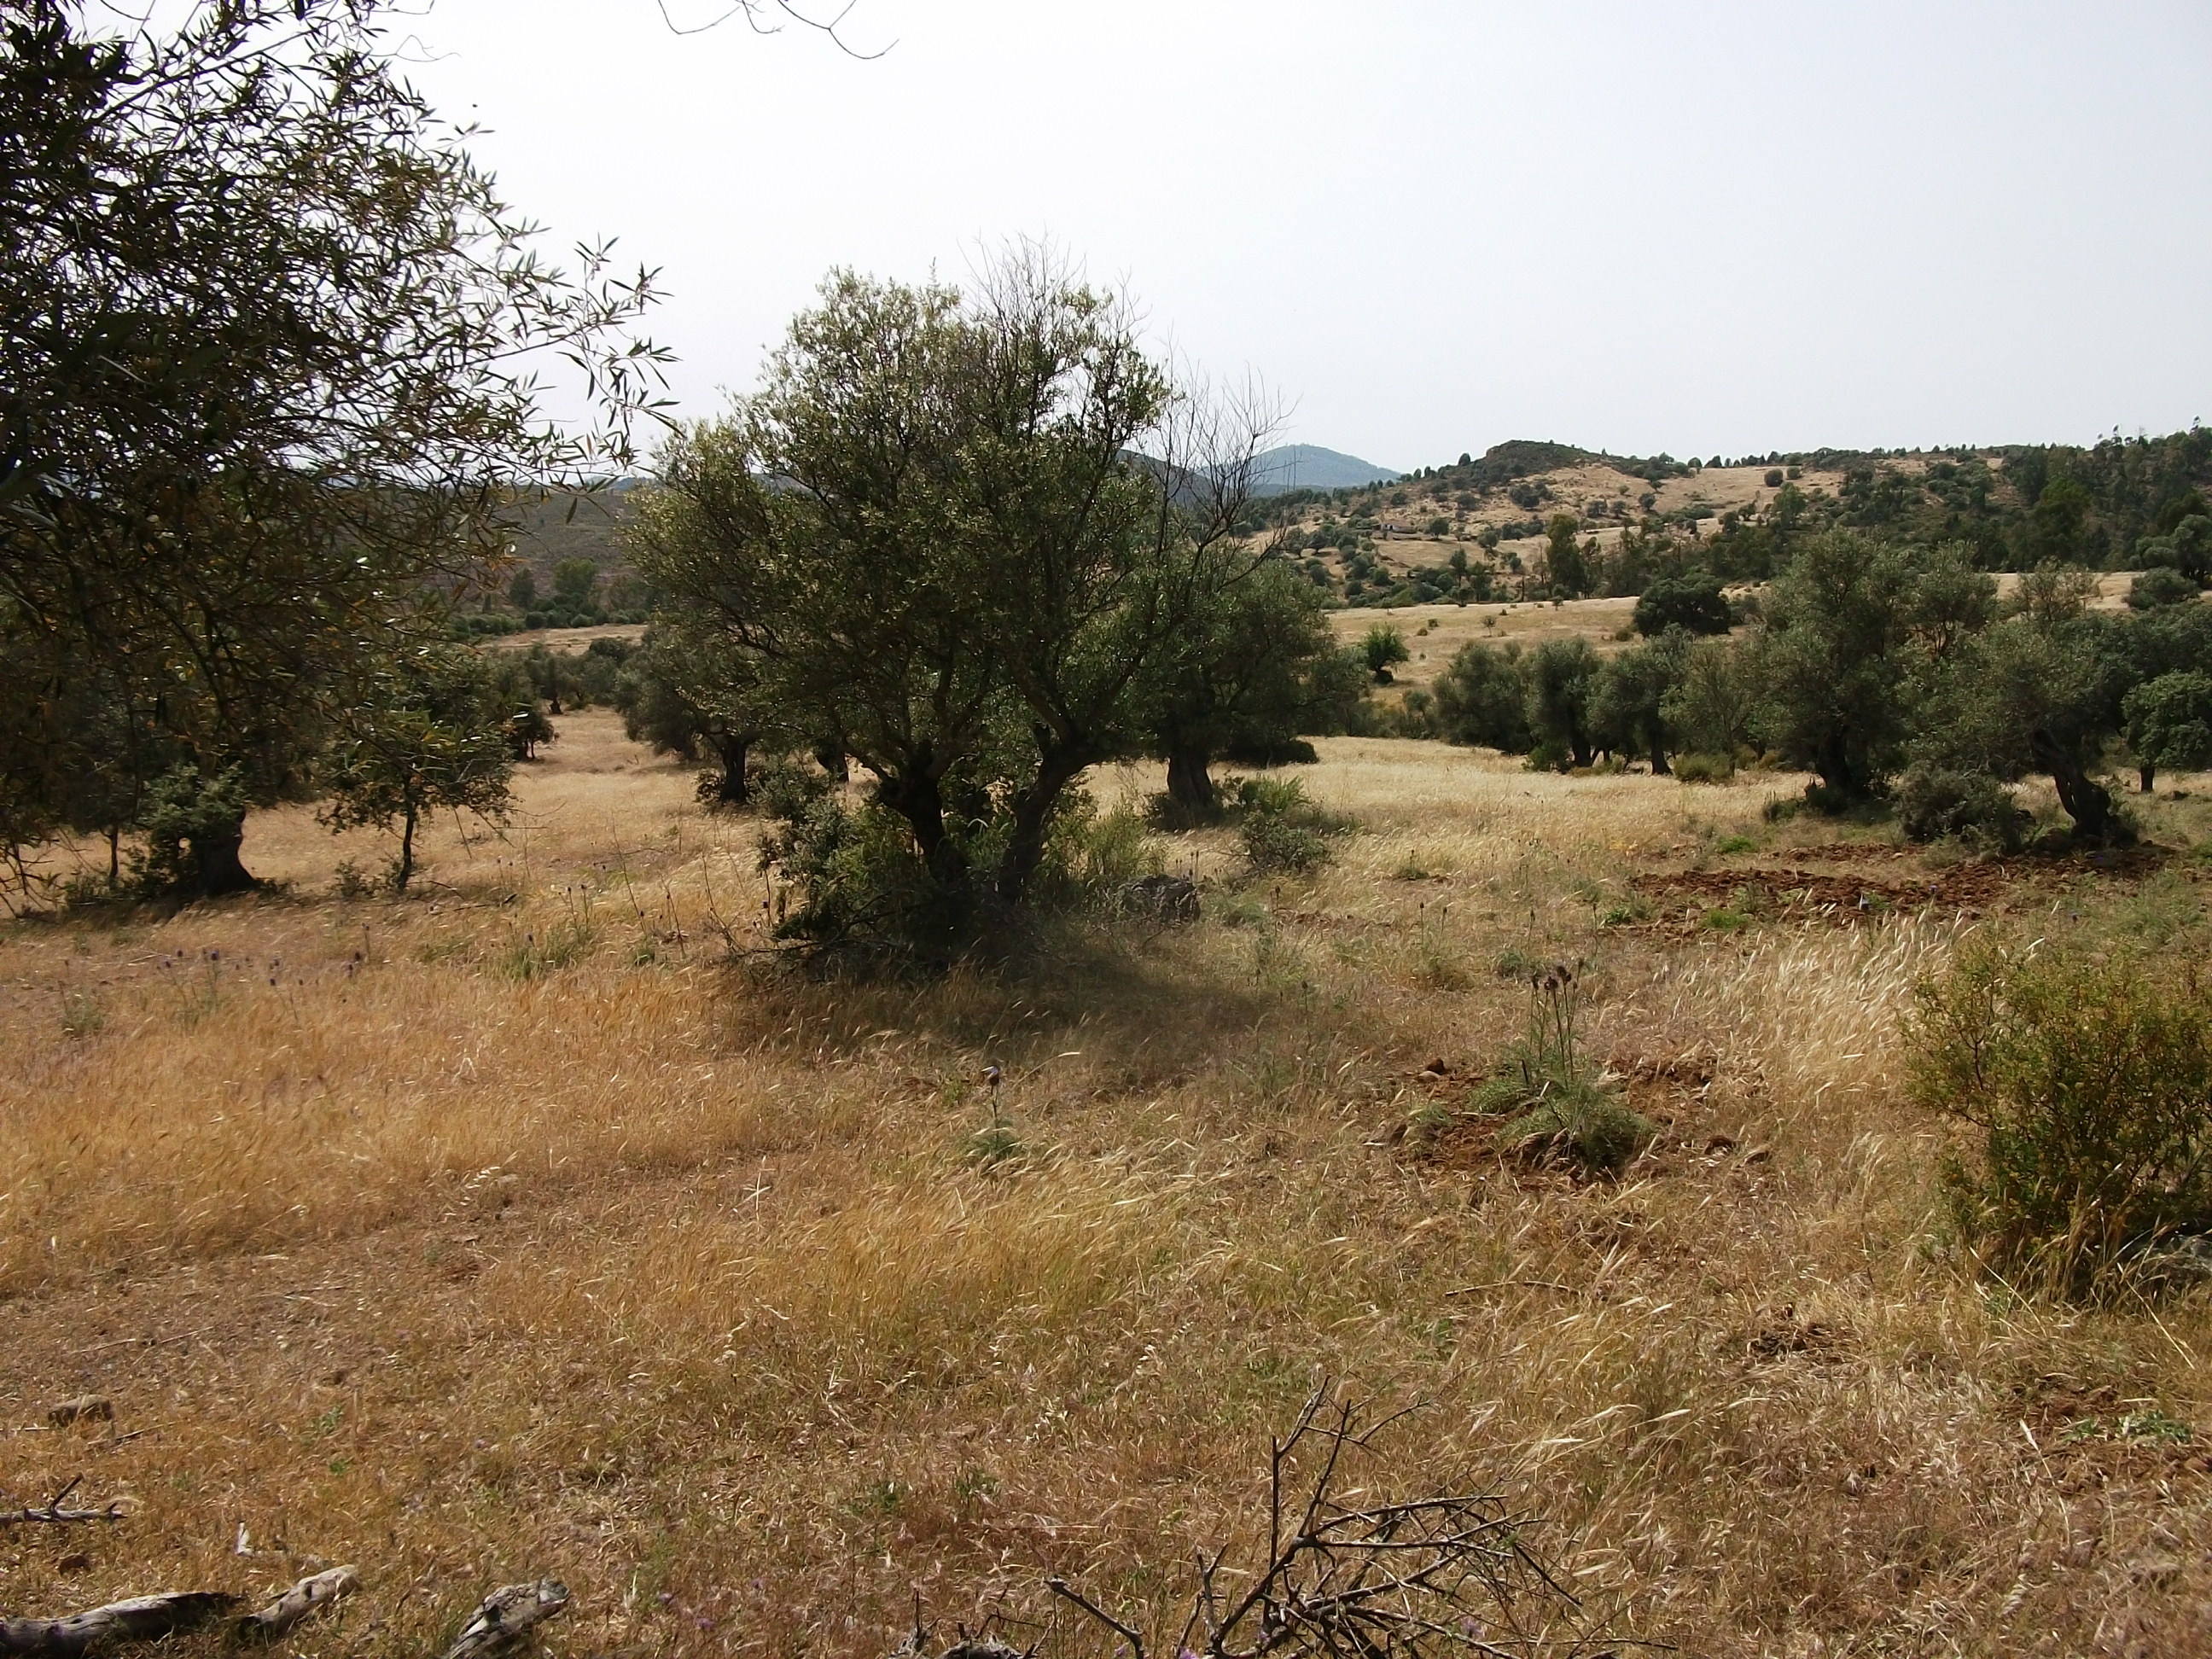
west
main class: Cropland
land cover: Olive groves
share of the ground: 25 - 50 %
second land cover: Spontaneously vegetated surfaces
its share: > 75 %
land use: Agriculture (excluding fallow land and kitchen gardens)
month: May
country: ES
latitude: 37.7259
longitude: -6.9646
